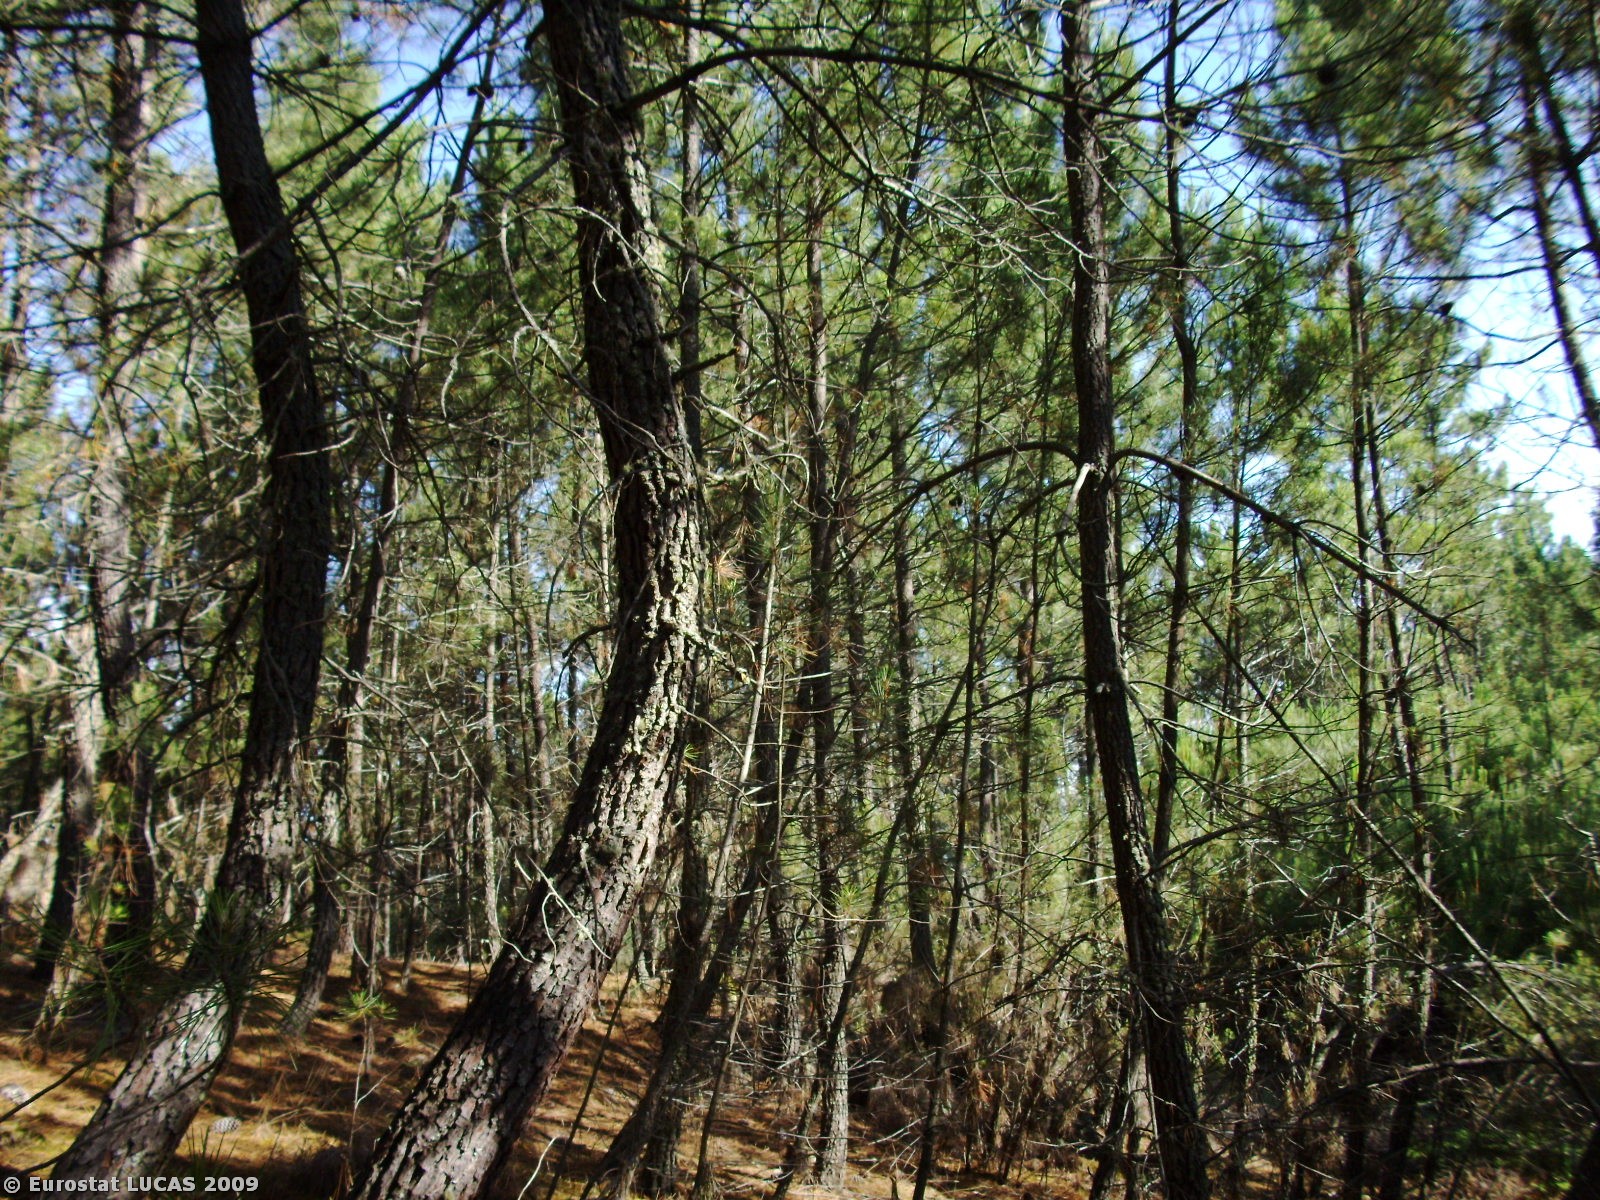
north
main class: Woodland
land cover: Coniferous woodland
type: coniferous forest of the mediterranean region
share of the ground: > 75 %
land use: Forestry
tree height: > 5 m
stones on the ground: 10 - 25 %
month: July
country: PT
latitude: 41.0141
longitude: -7.7607
